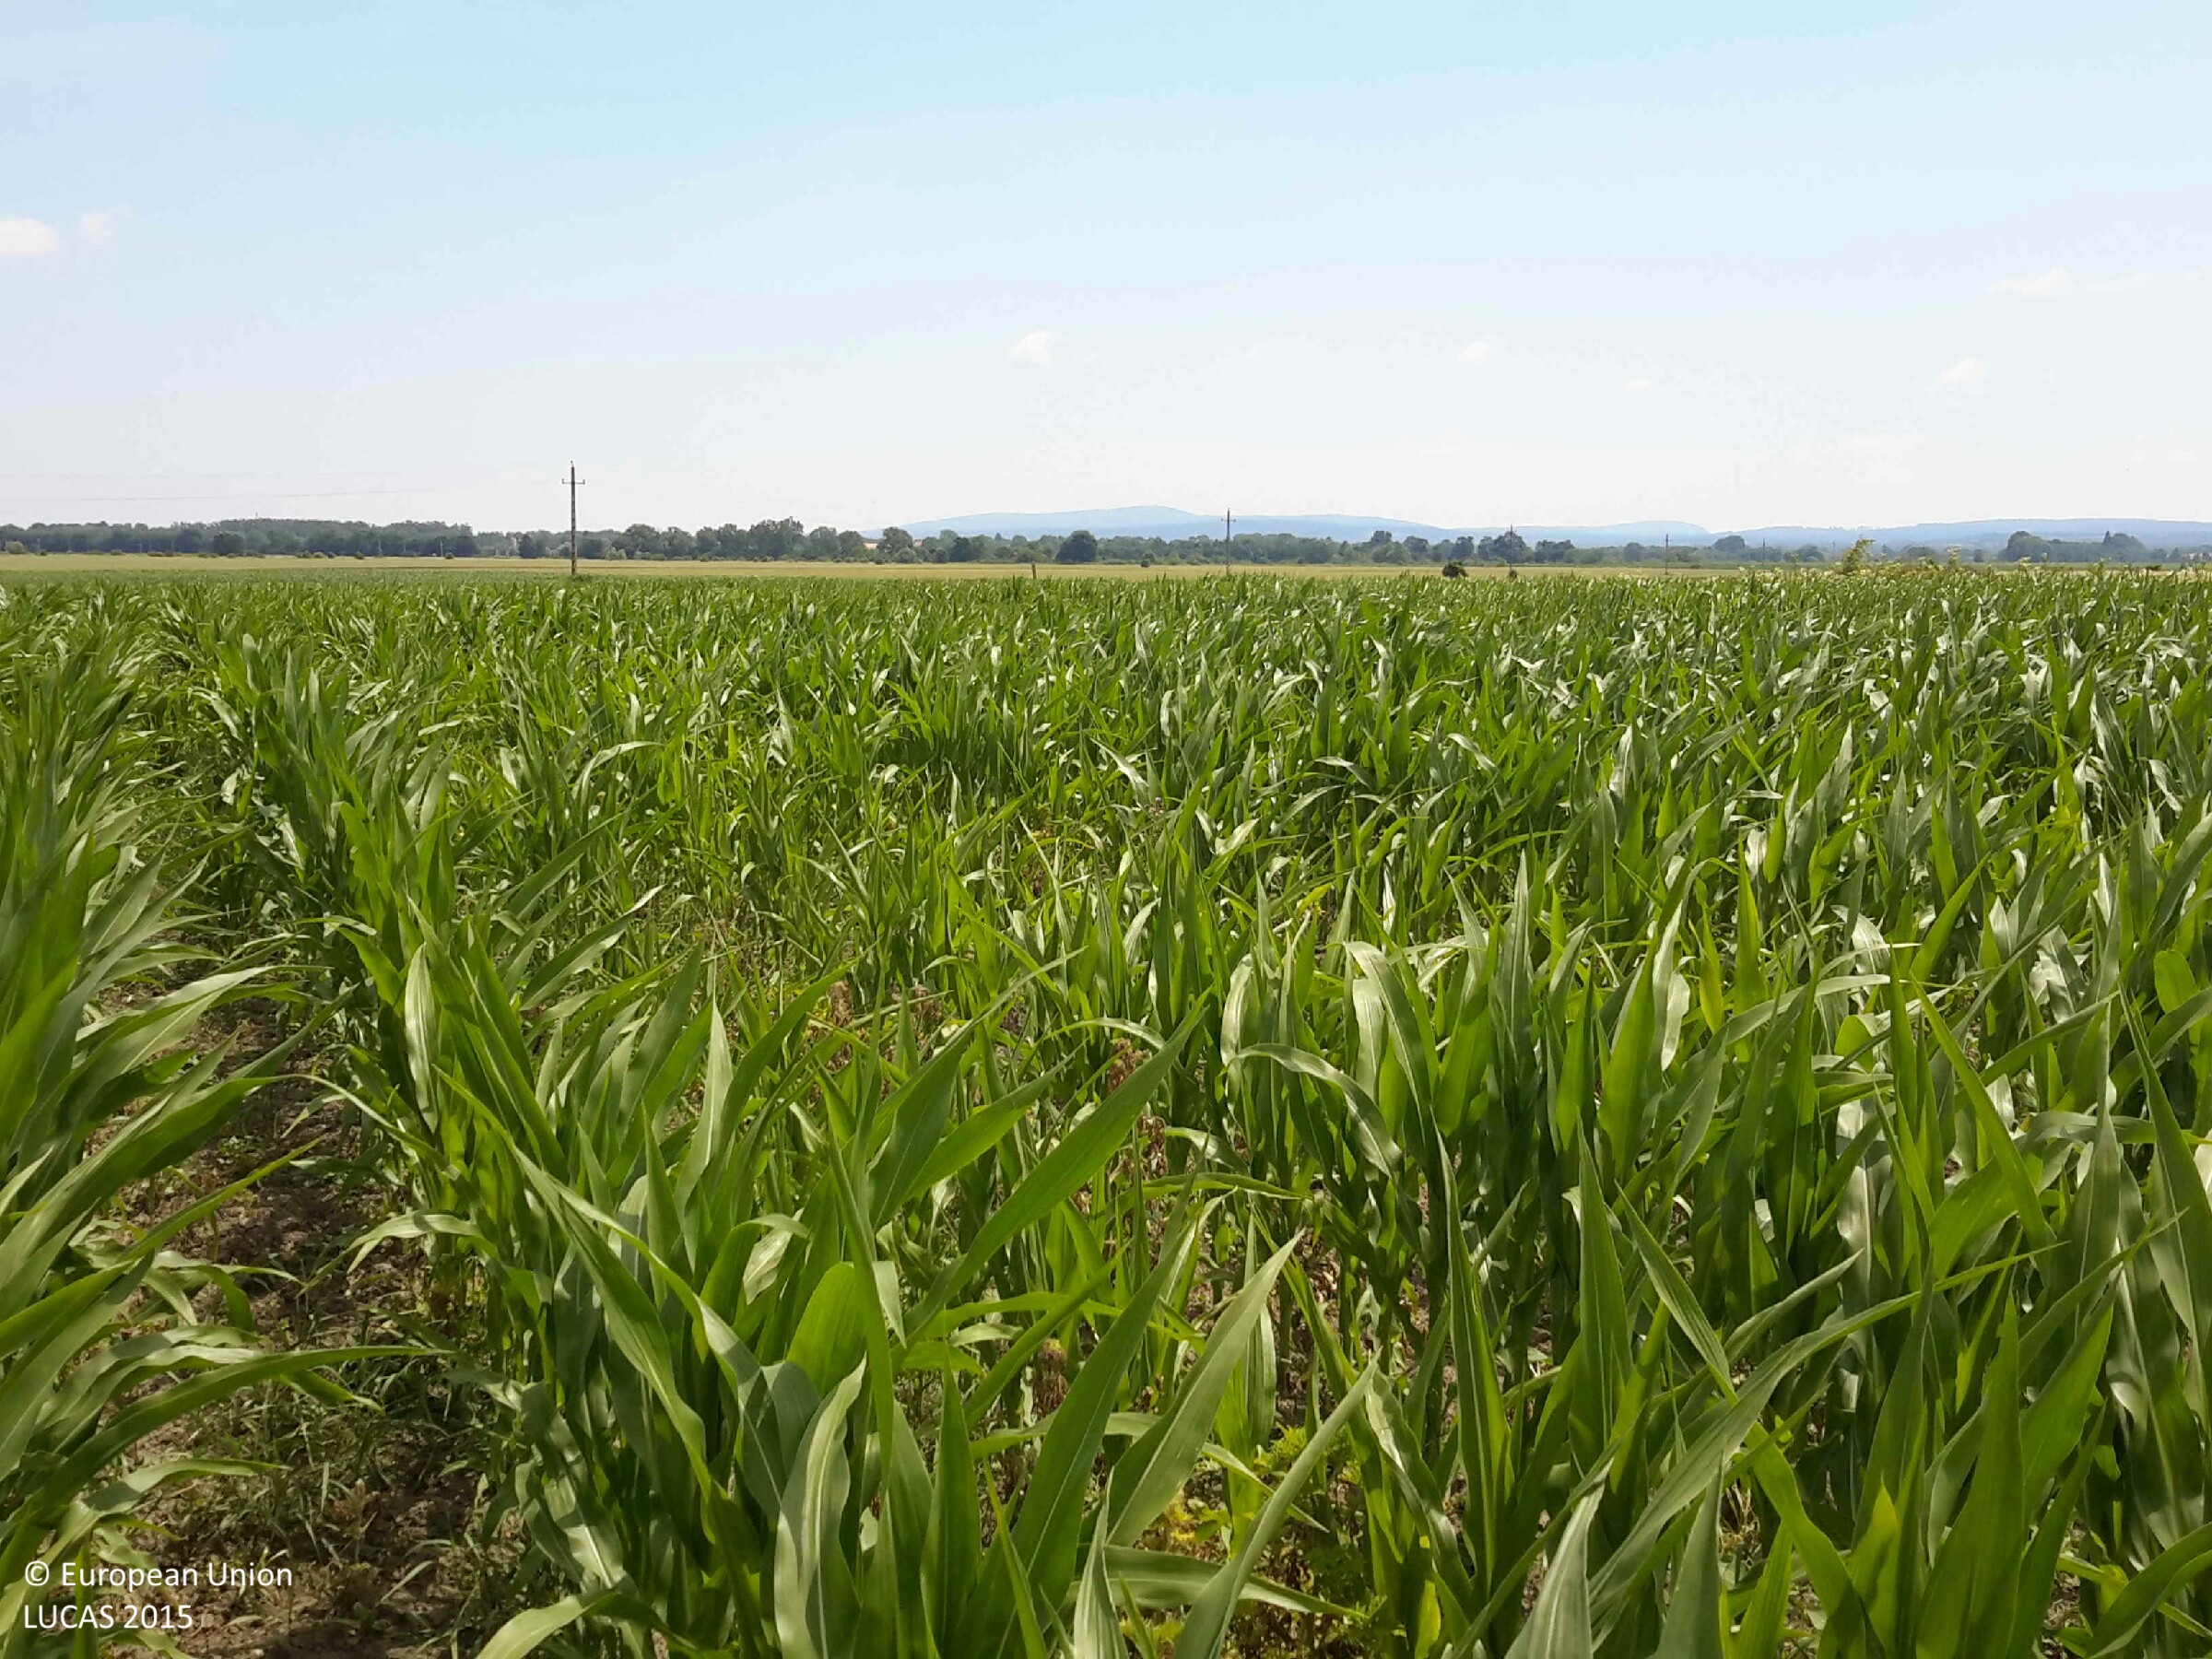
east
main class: Cropland
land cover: Maize
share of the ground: 50 - 75 %
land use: Agriculture (excluding fallow land and kitchen gardens)
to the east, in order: Maize; Barley
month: June
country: HU
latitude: 47.3024
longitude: 17.4534
